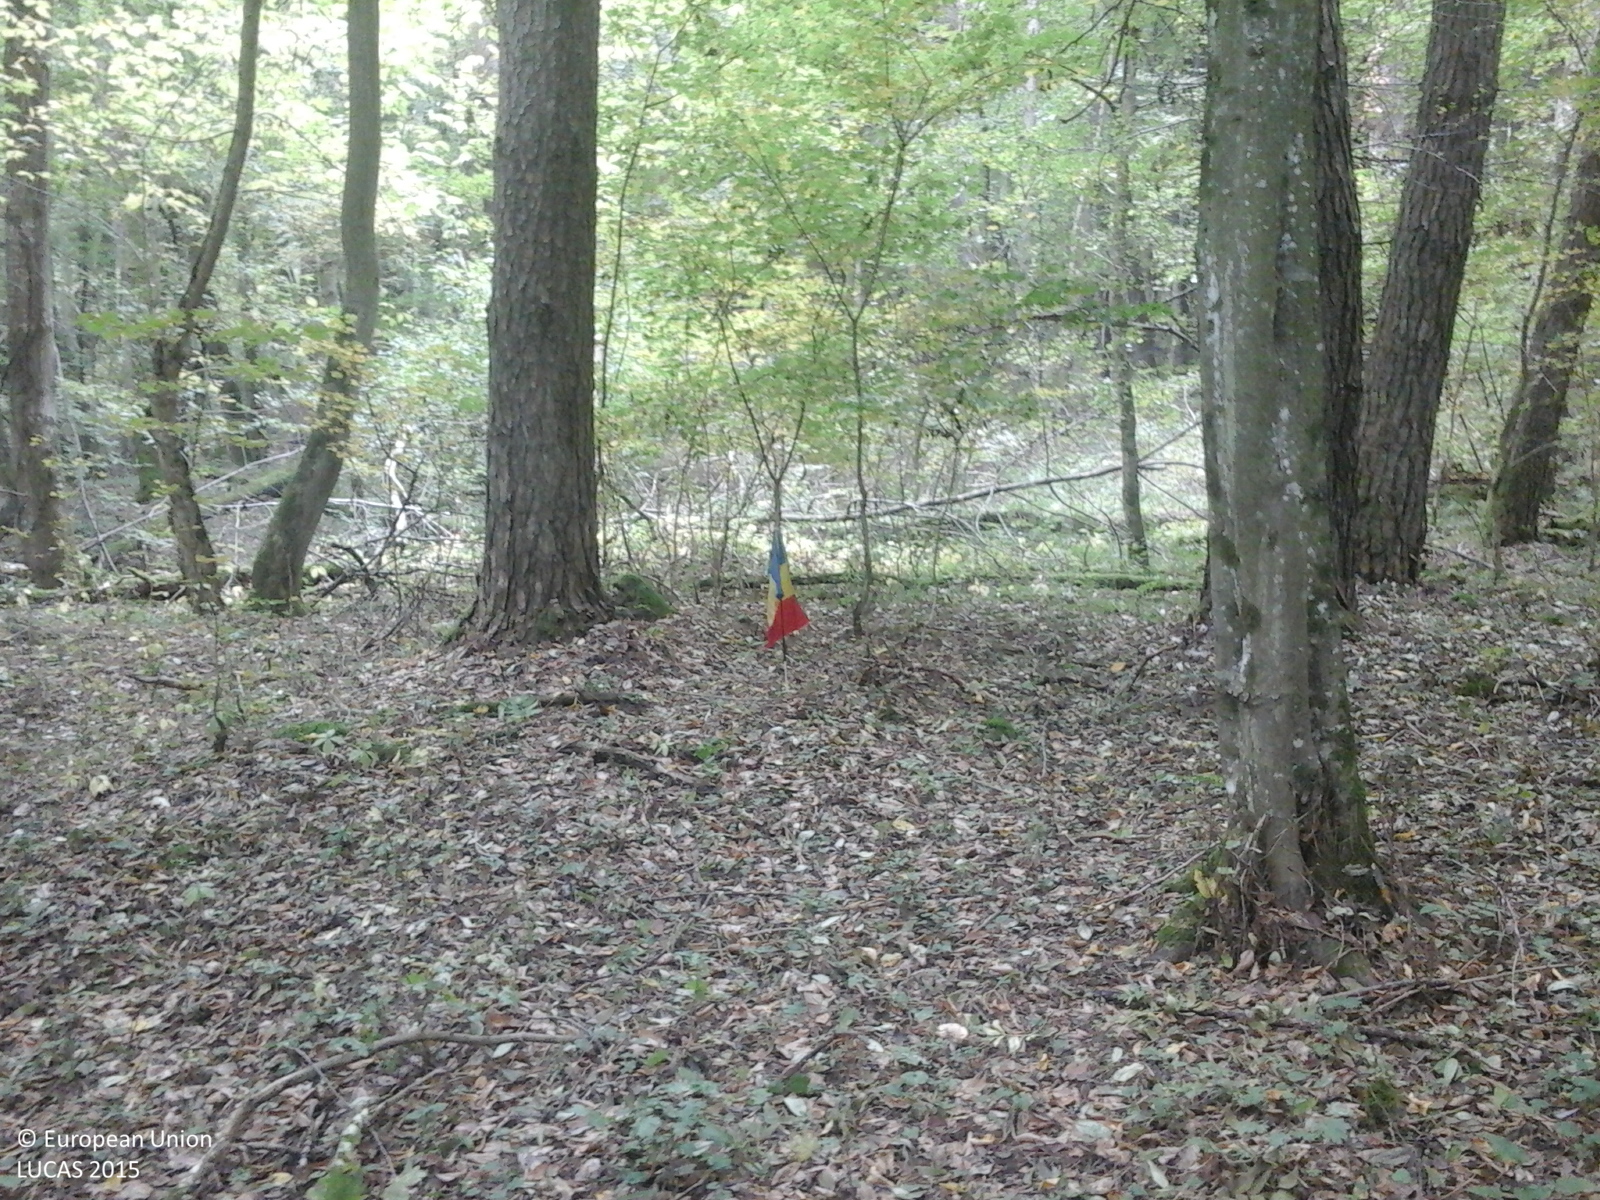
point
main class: Woodland
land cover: Other mixed woodland
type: beech forest
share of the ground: > 75 %
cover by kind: broadleaved forest trees 75 %, coniferous forest trees 25 %
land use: Forestry
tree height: > 5 m
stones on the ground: 10 - 25 %
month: October
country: RO
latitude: 45.9983
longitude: 25.1393
